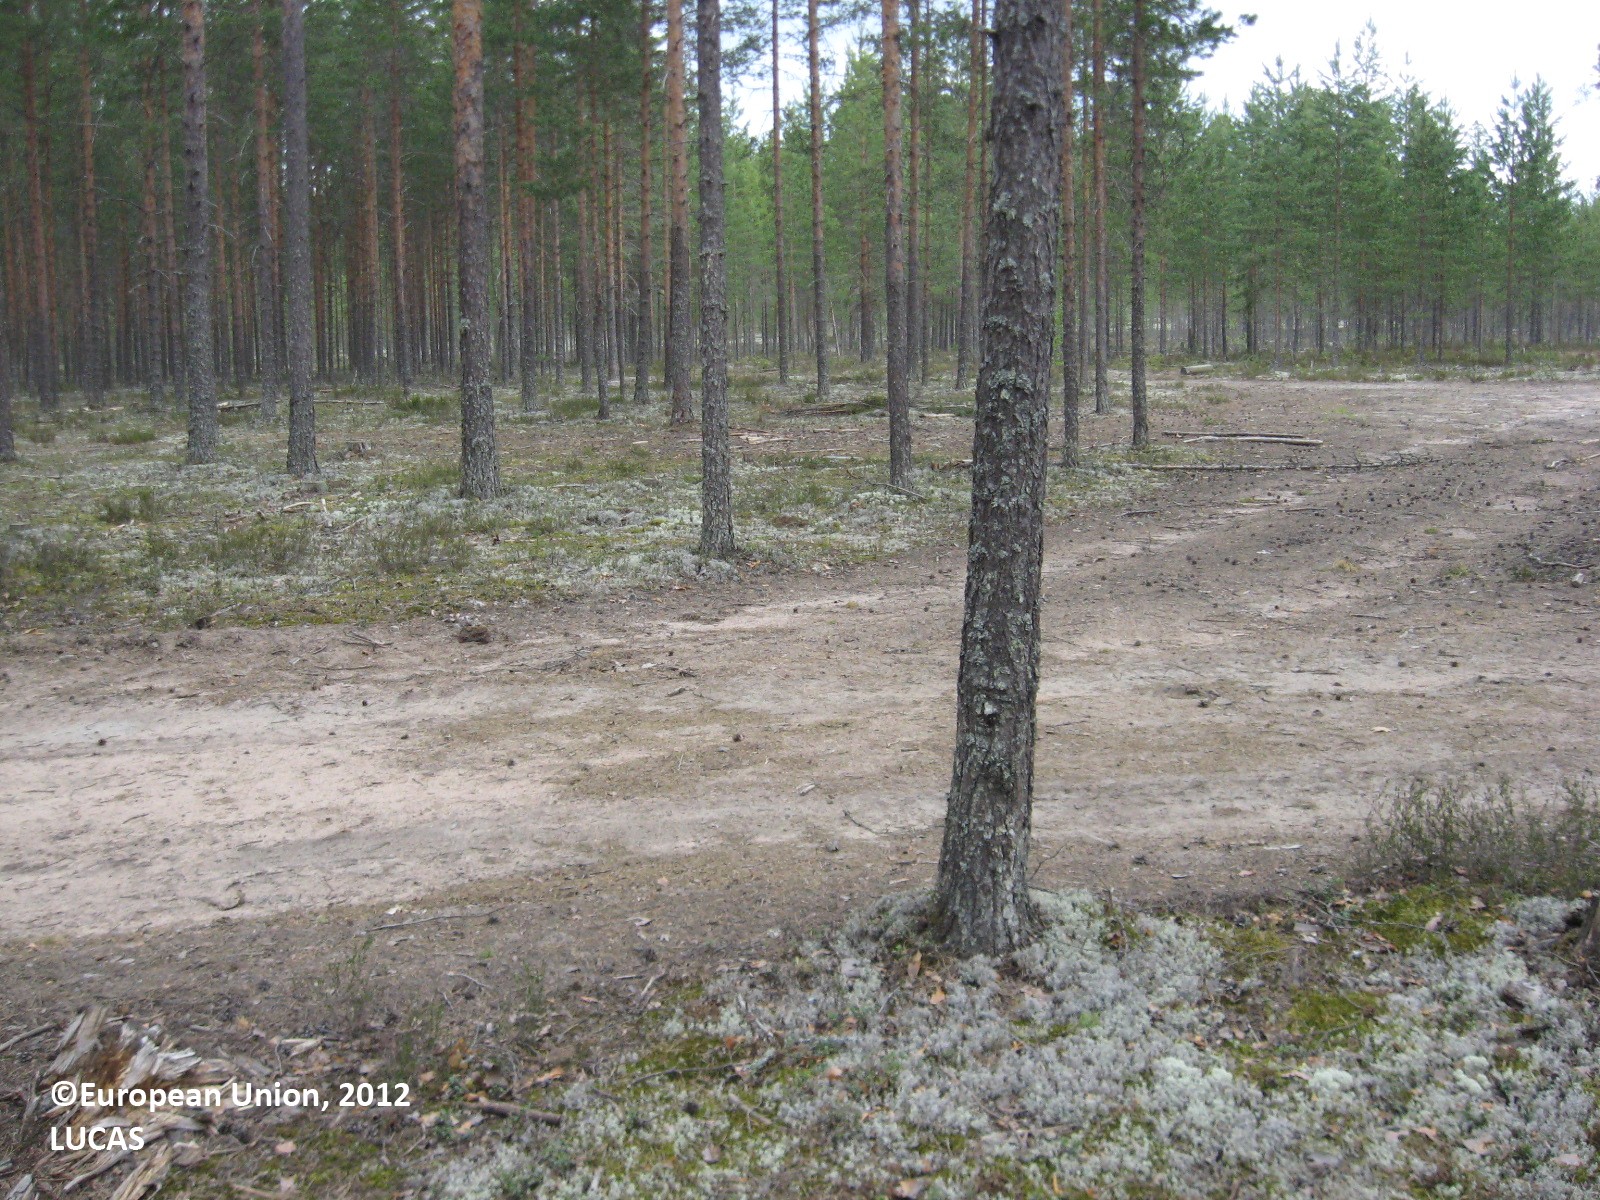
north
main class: Woodland
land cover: Pine dominated coniferous woodland
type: boreal forest
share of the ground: 50 - 75 %
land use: Community services
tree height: > 5 m
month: May
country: FI
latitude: 61.7640
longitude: 22.6639
